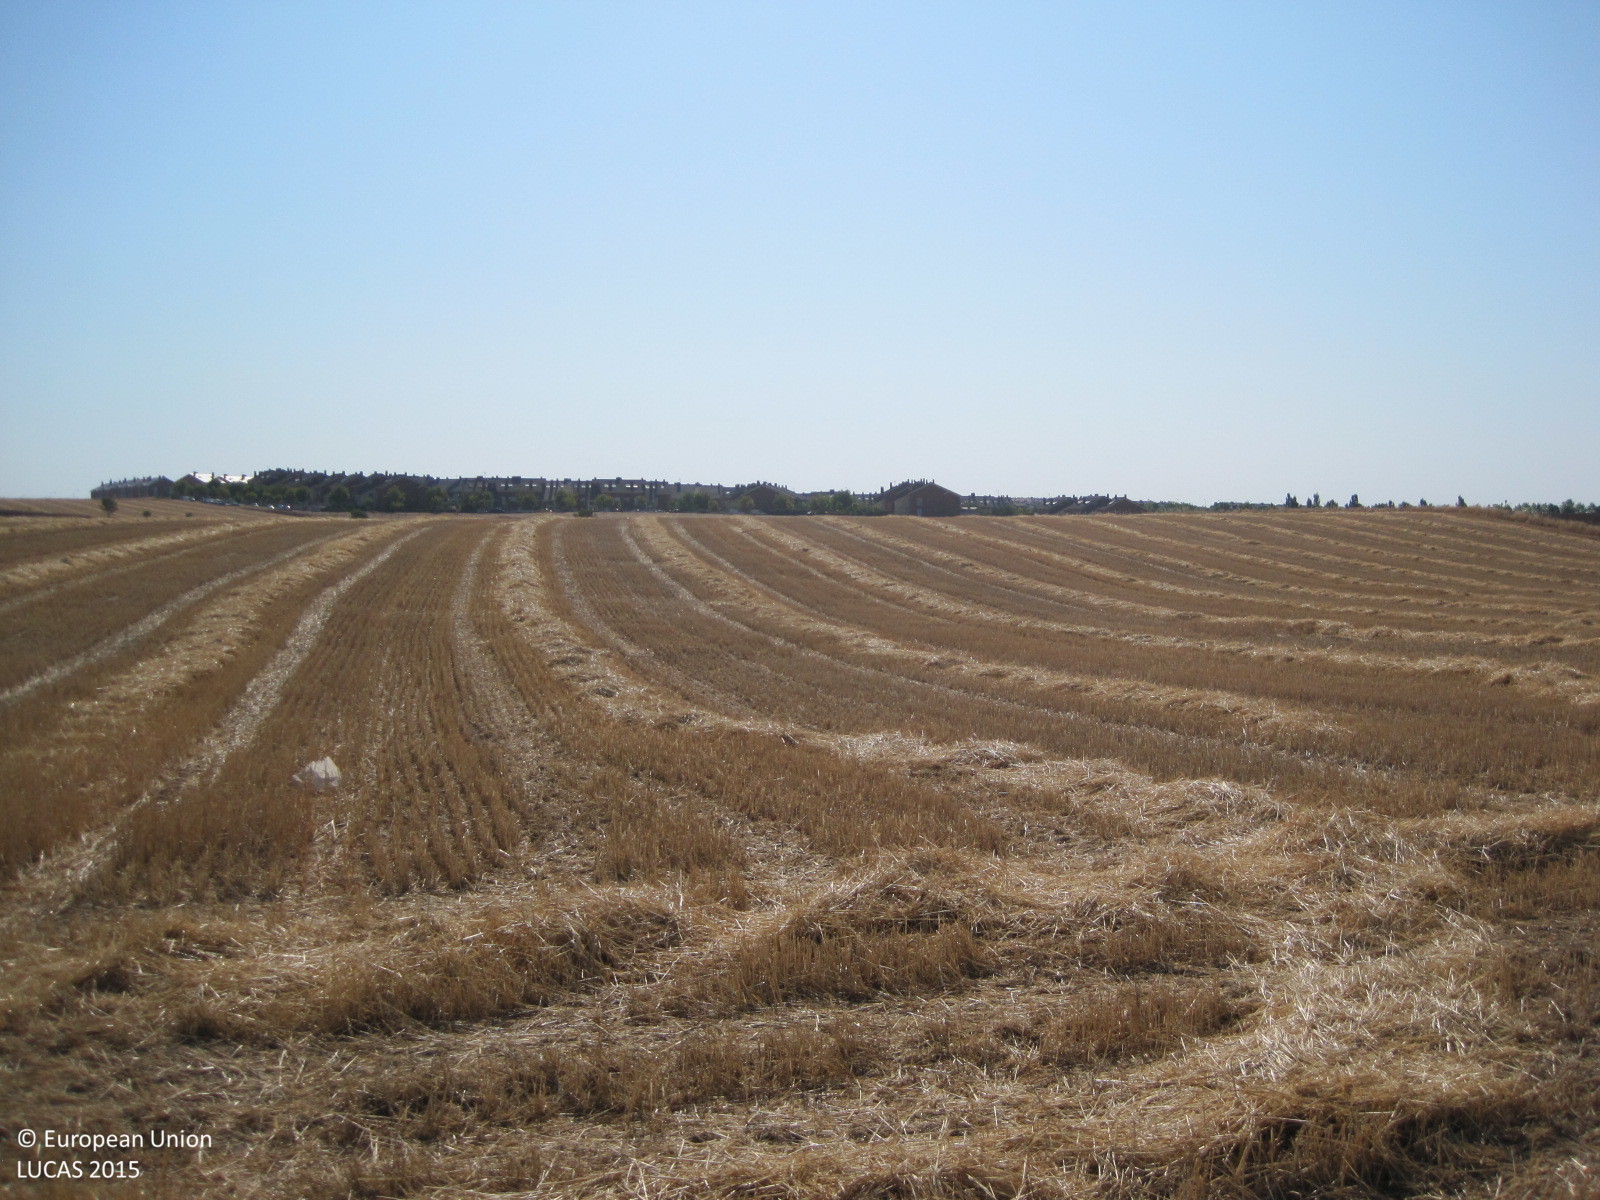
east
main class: Cropland
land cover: Common wheat
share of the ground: < 10 %
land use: Agriculture (excluding fallow land and kitchen gardens)
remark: Harvested field
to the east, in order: Common wheat
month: July
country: ES
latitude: 40.1587
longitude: -3.8547
